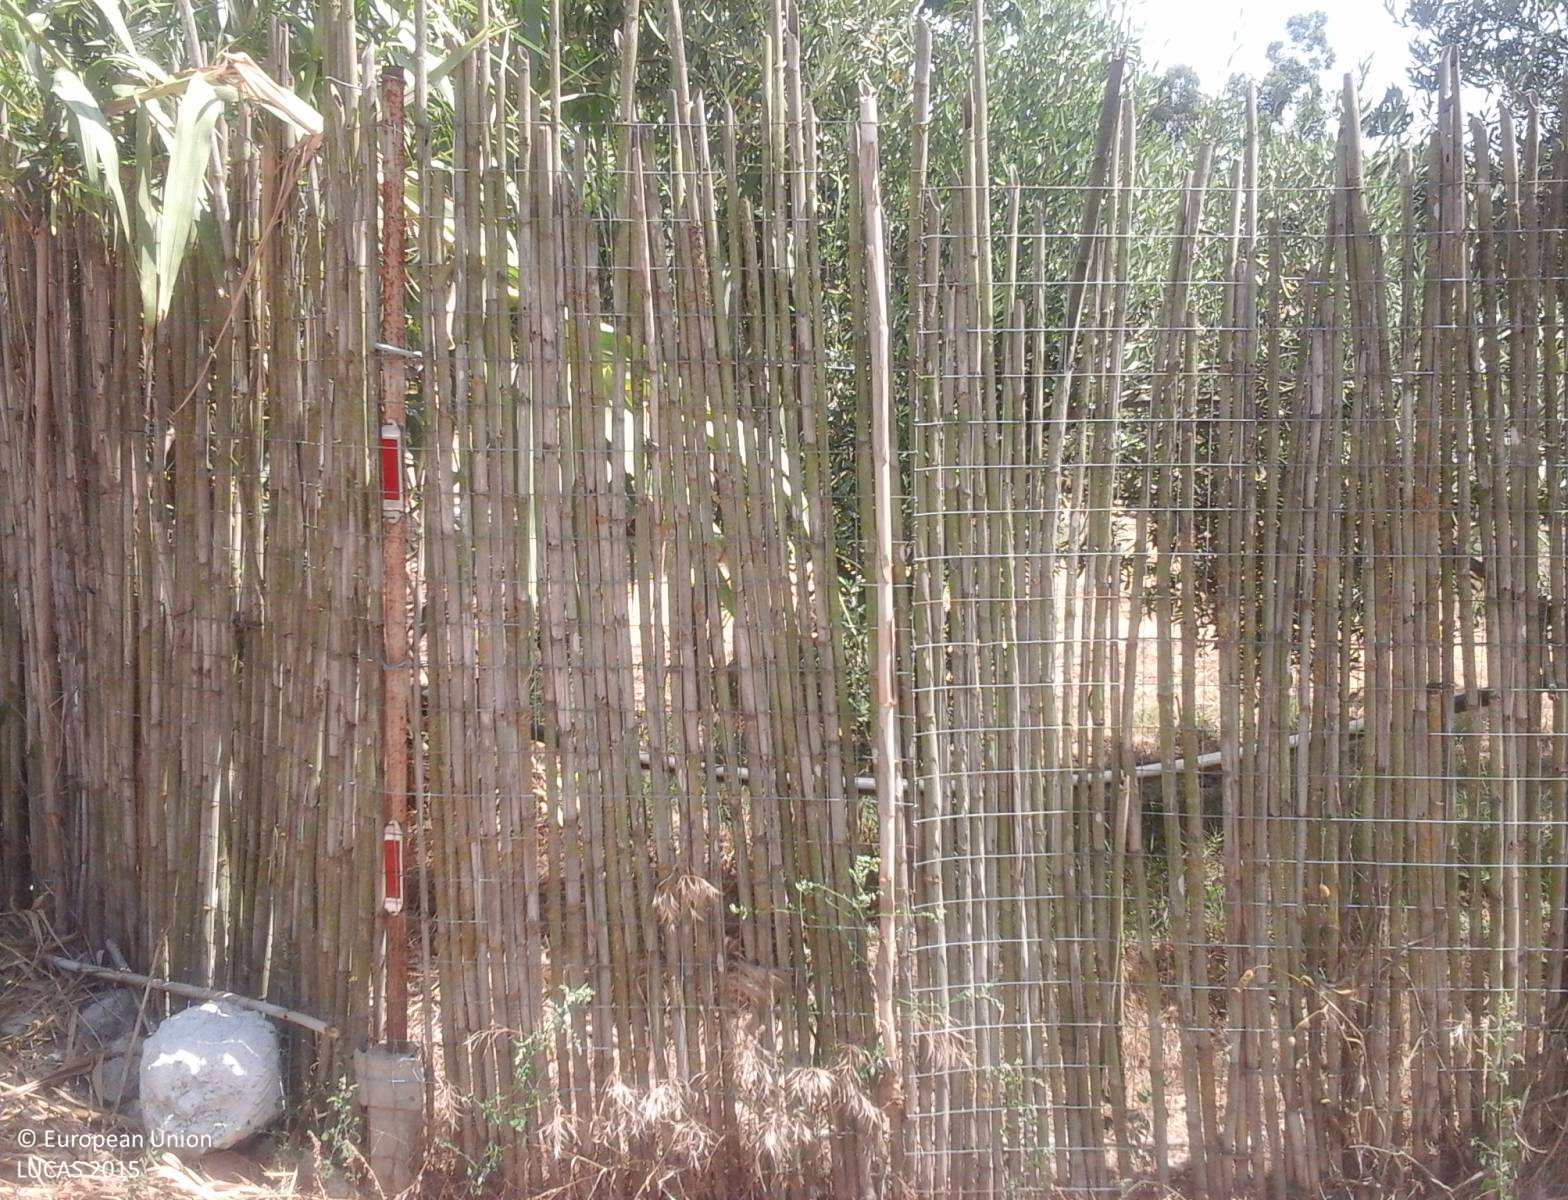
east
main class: Cropland
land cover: Oranges
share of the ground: > 75 %
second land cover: Grassland without tree/shrub cover
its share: > 75 %
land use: Agriculture (excluding fallow land and kitchen gardens)
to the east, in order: Oranges; Grassland without tree/shrub cover; Managed hedges; Fences; Paved roads, cycling and walking lanes; Fences; Managed hedges; Oranges; Other fruit trees and berries; Artificial constructions in urban areas; Permanent crops (only in case pi); Tracks; Fences; Oranges; Fences; Tracks; Fences; Abandoned hedges; Oranges; Electric lines; Oranges; Abandoned hedges; Fences; Other bare soil
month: August
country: IT
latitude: 39.4281
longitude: 8.9030
